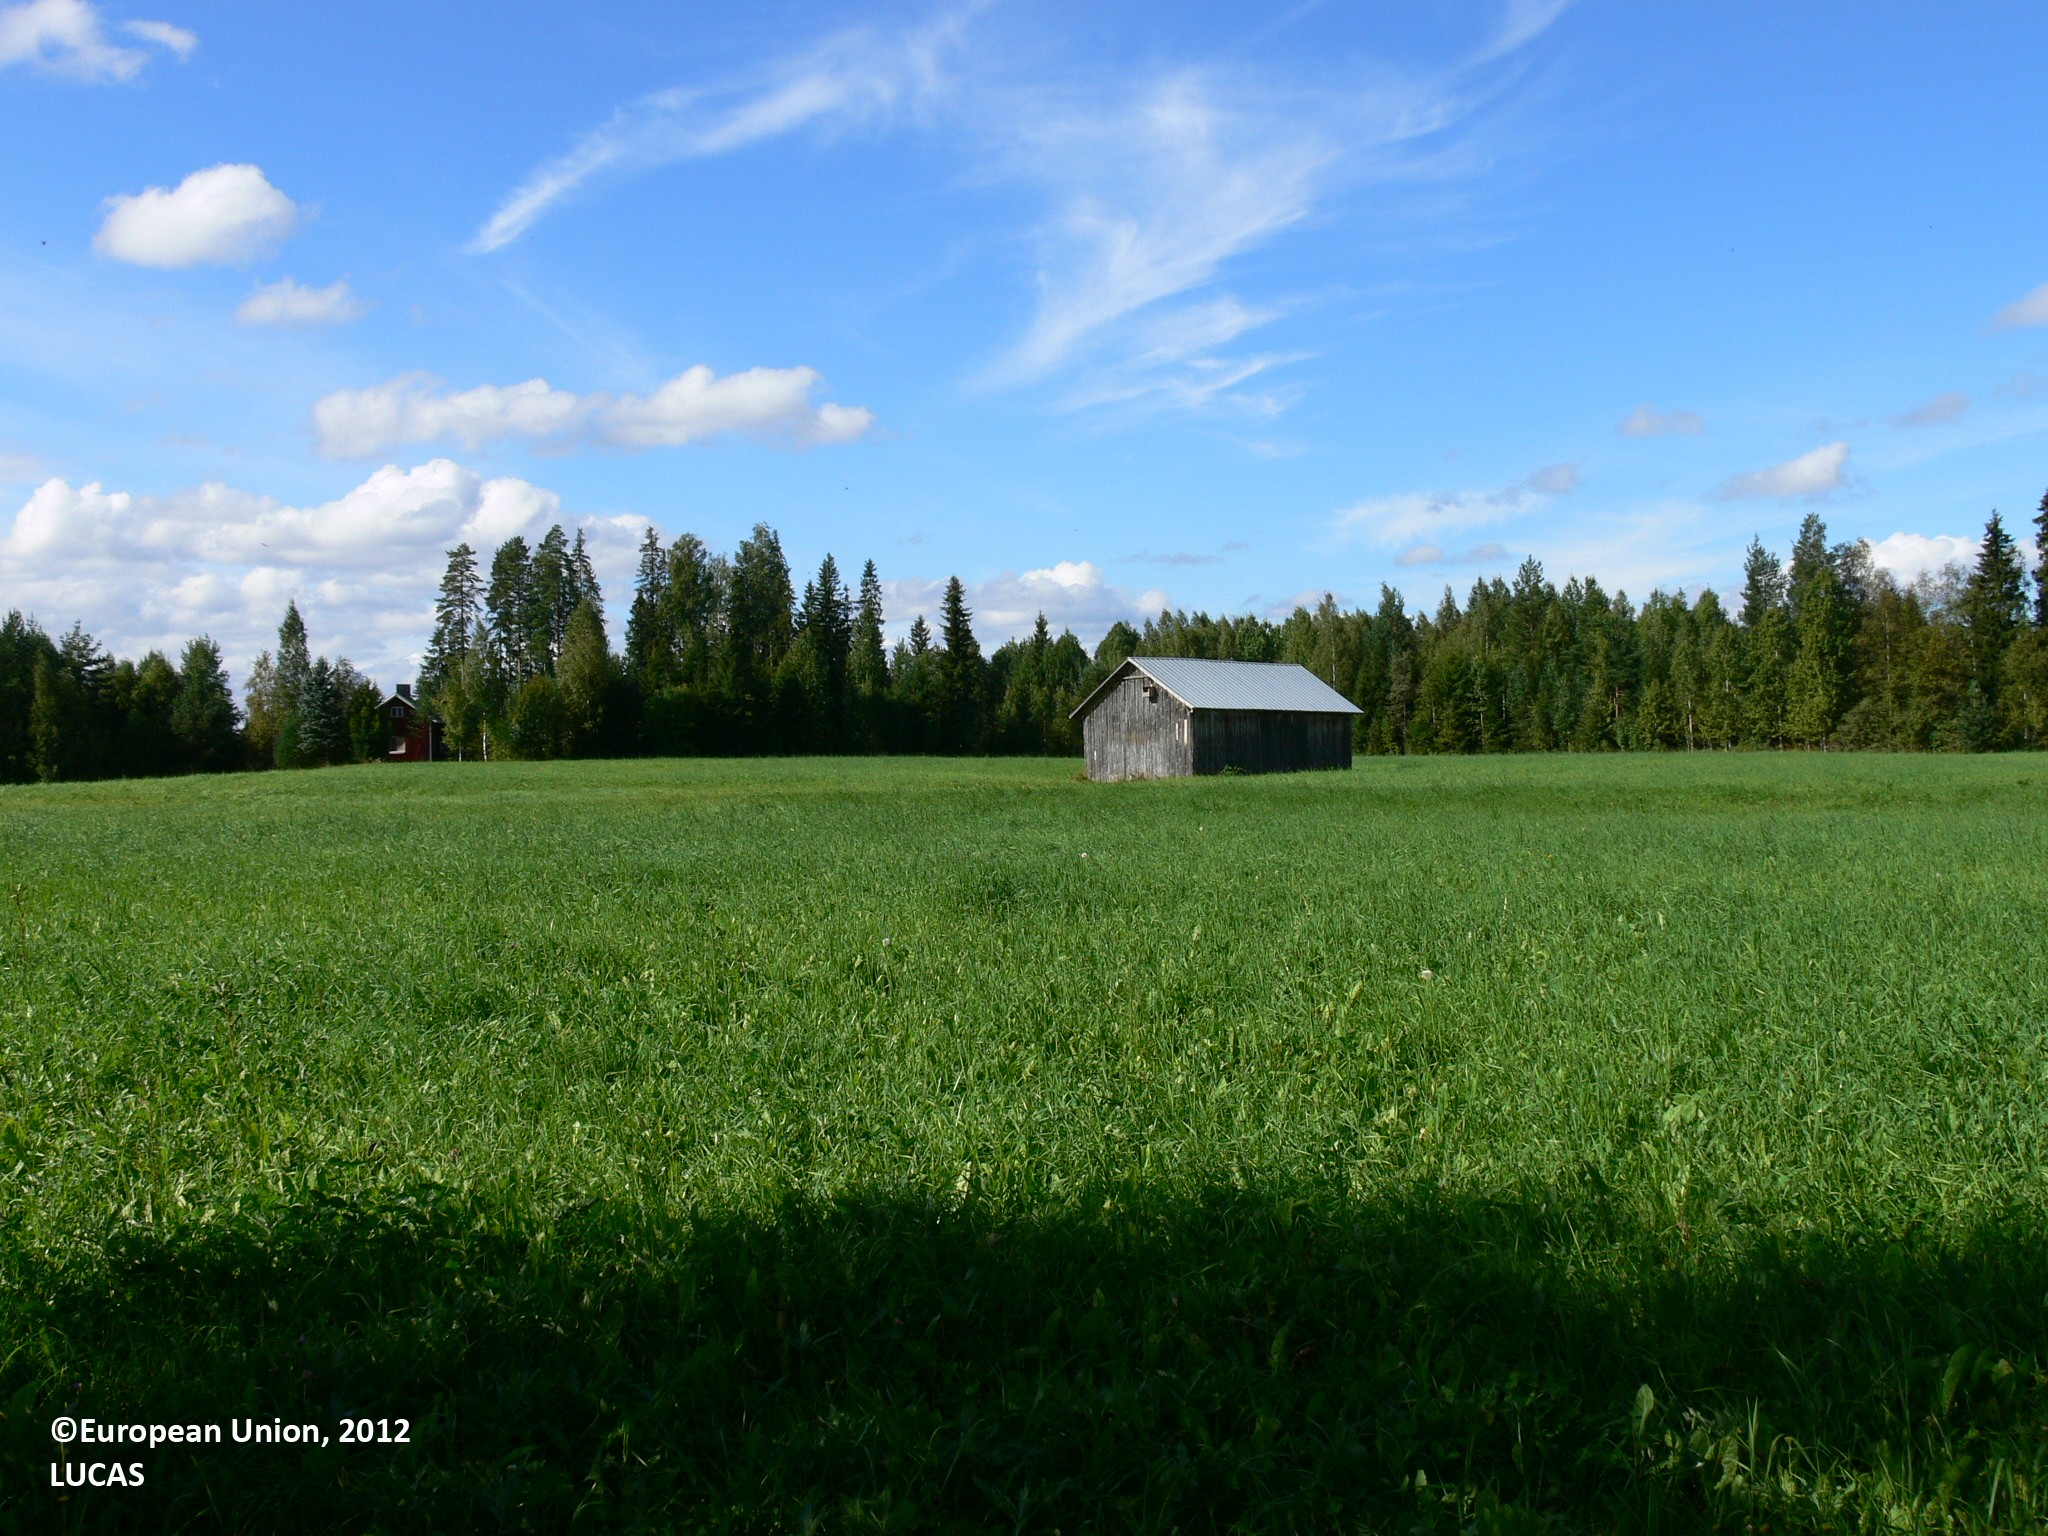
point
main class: Cropland
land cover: Temporary grasslands
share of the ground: > 75 %
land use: Agriculture (excluding fallow land and kitchen gardens)
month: August
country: FI
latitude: 62.0724
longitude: 30.1179
